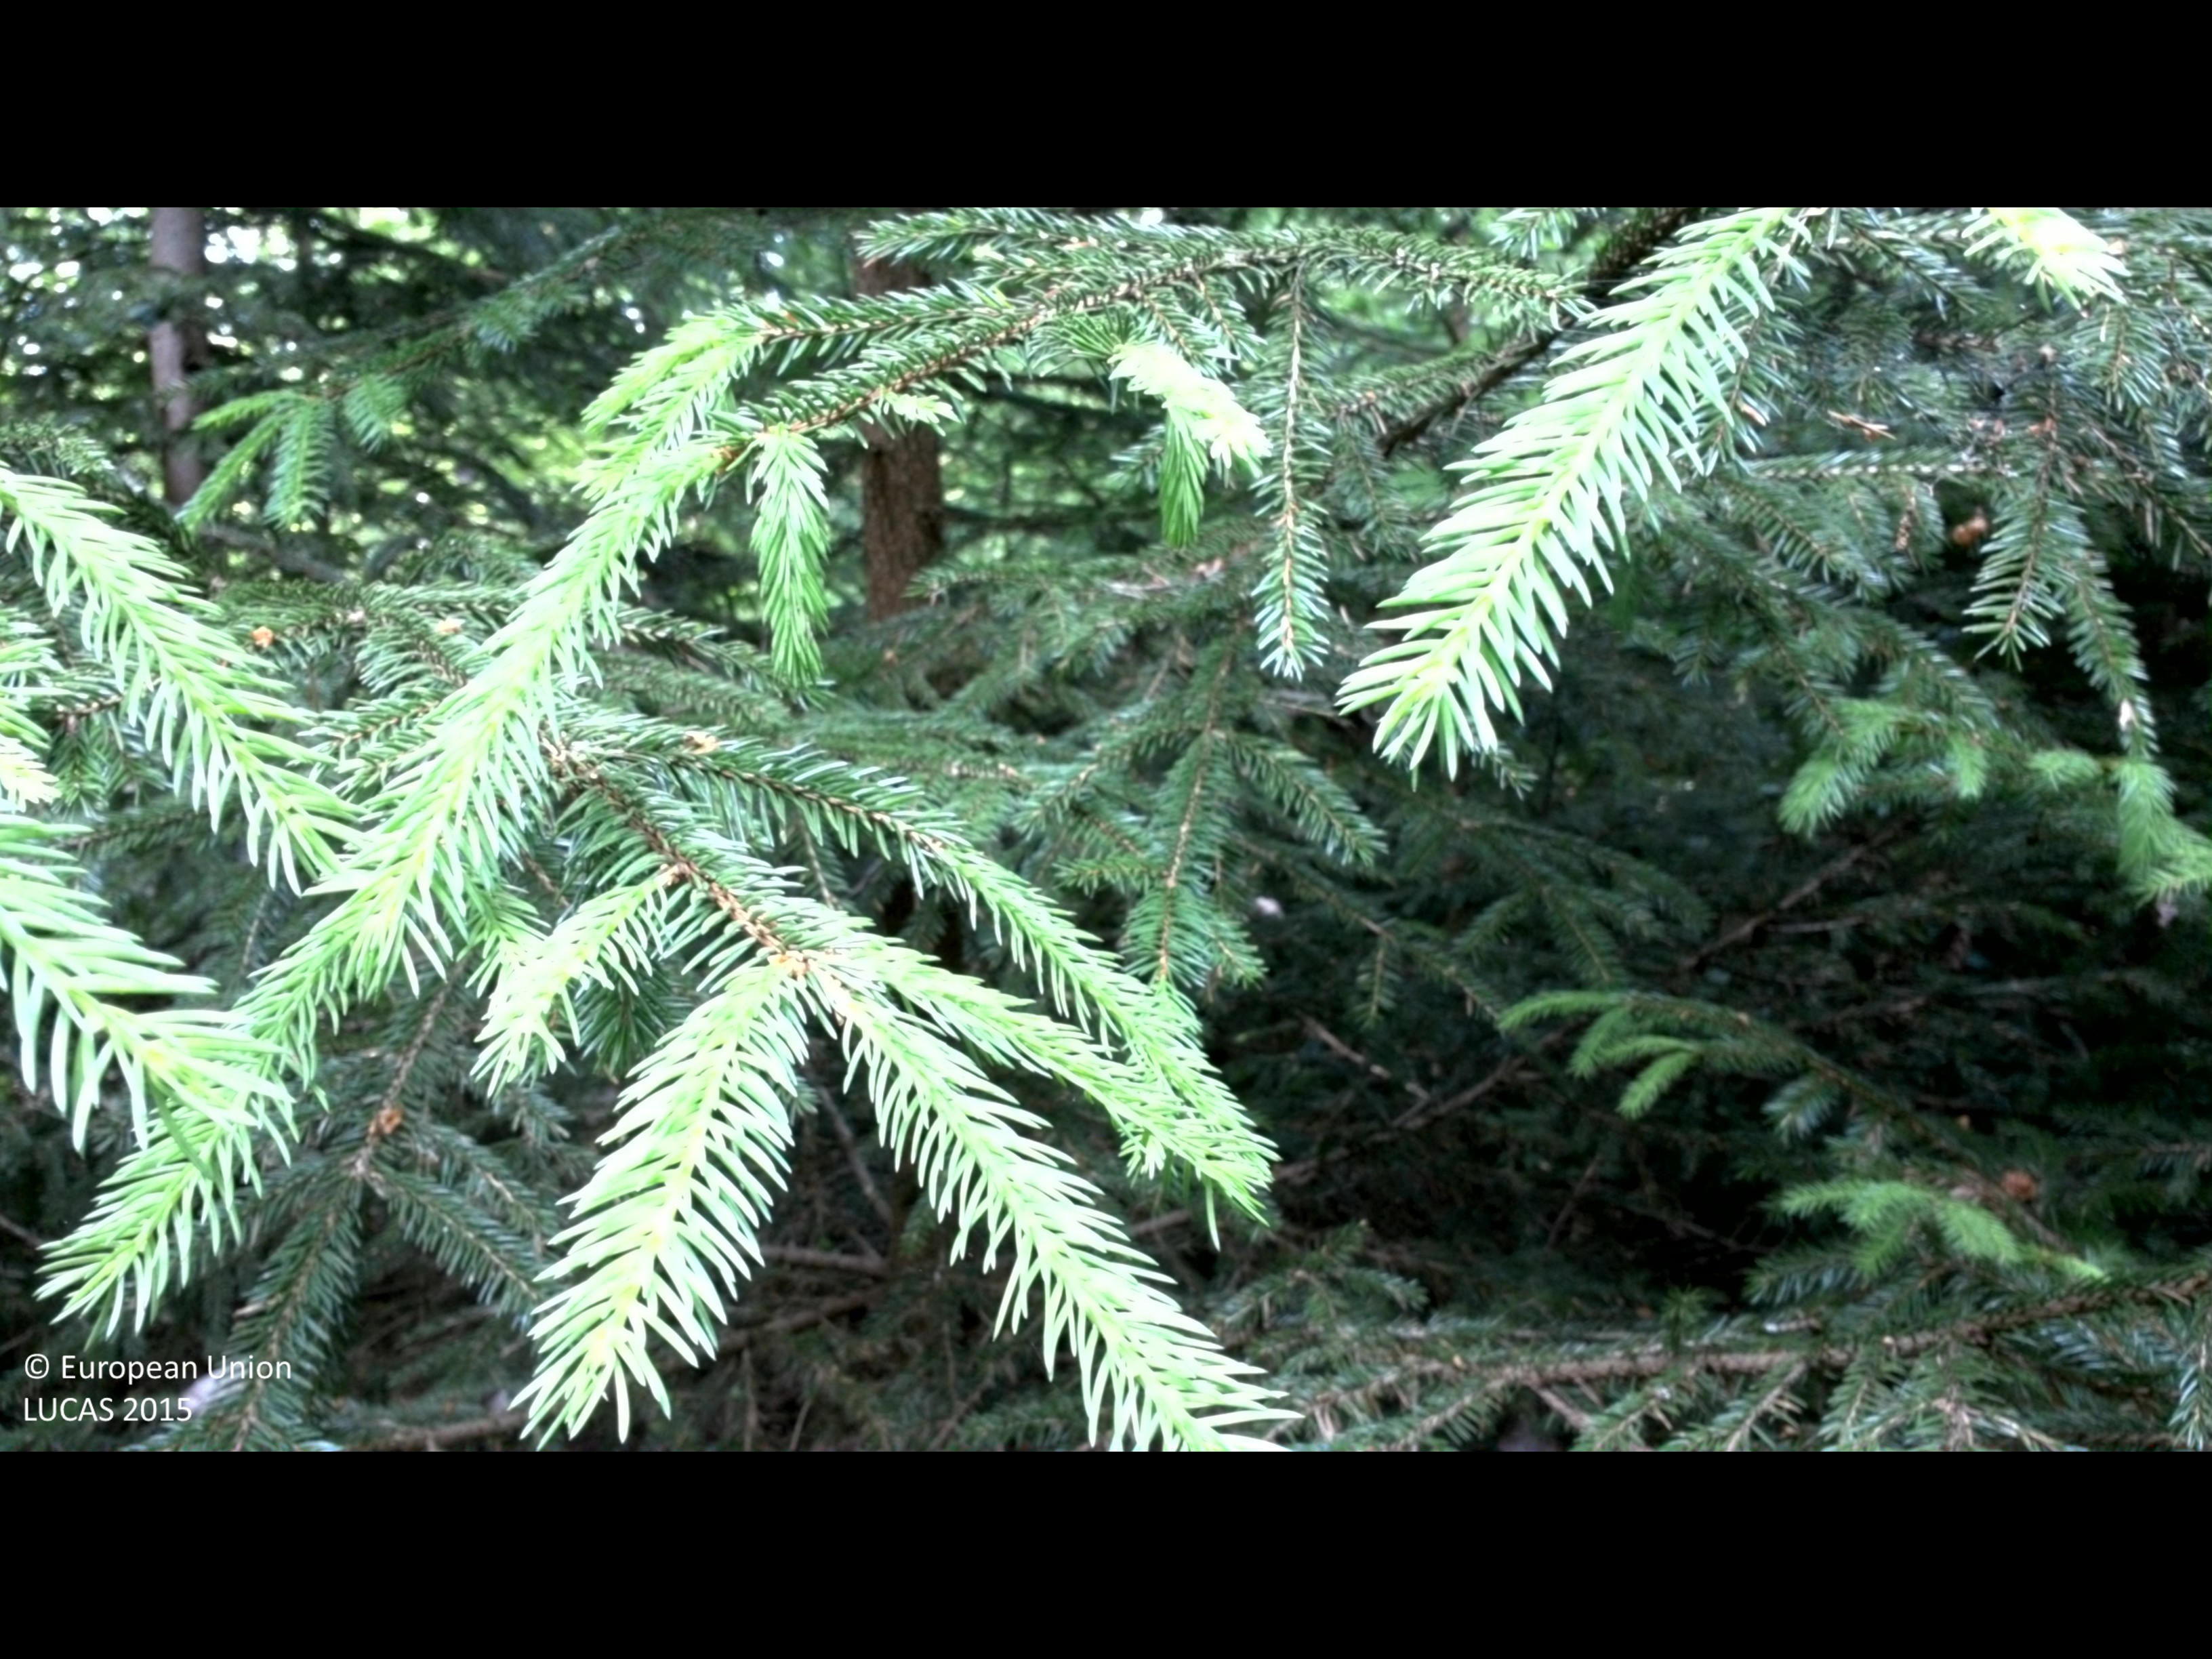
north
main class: Woodland
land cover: Spruce dominated mixed woodland
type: boreal forest
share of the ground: > 75 %
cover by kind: coniferous forest trees 50 %, broadleaved forest trees 40 %, shrubs 10 %
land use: Forestry
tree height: < 5 m
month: July
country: SE
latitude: 56.4502
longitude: 14.5241
